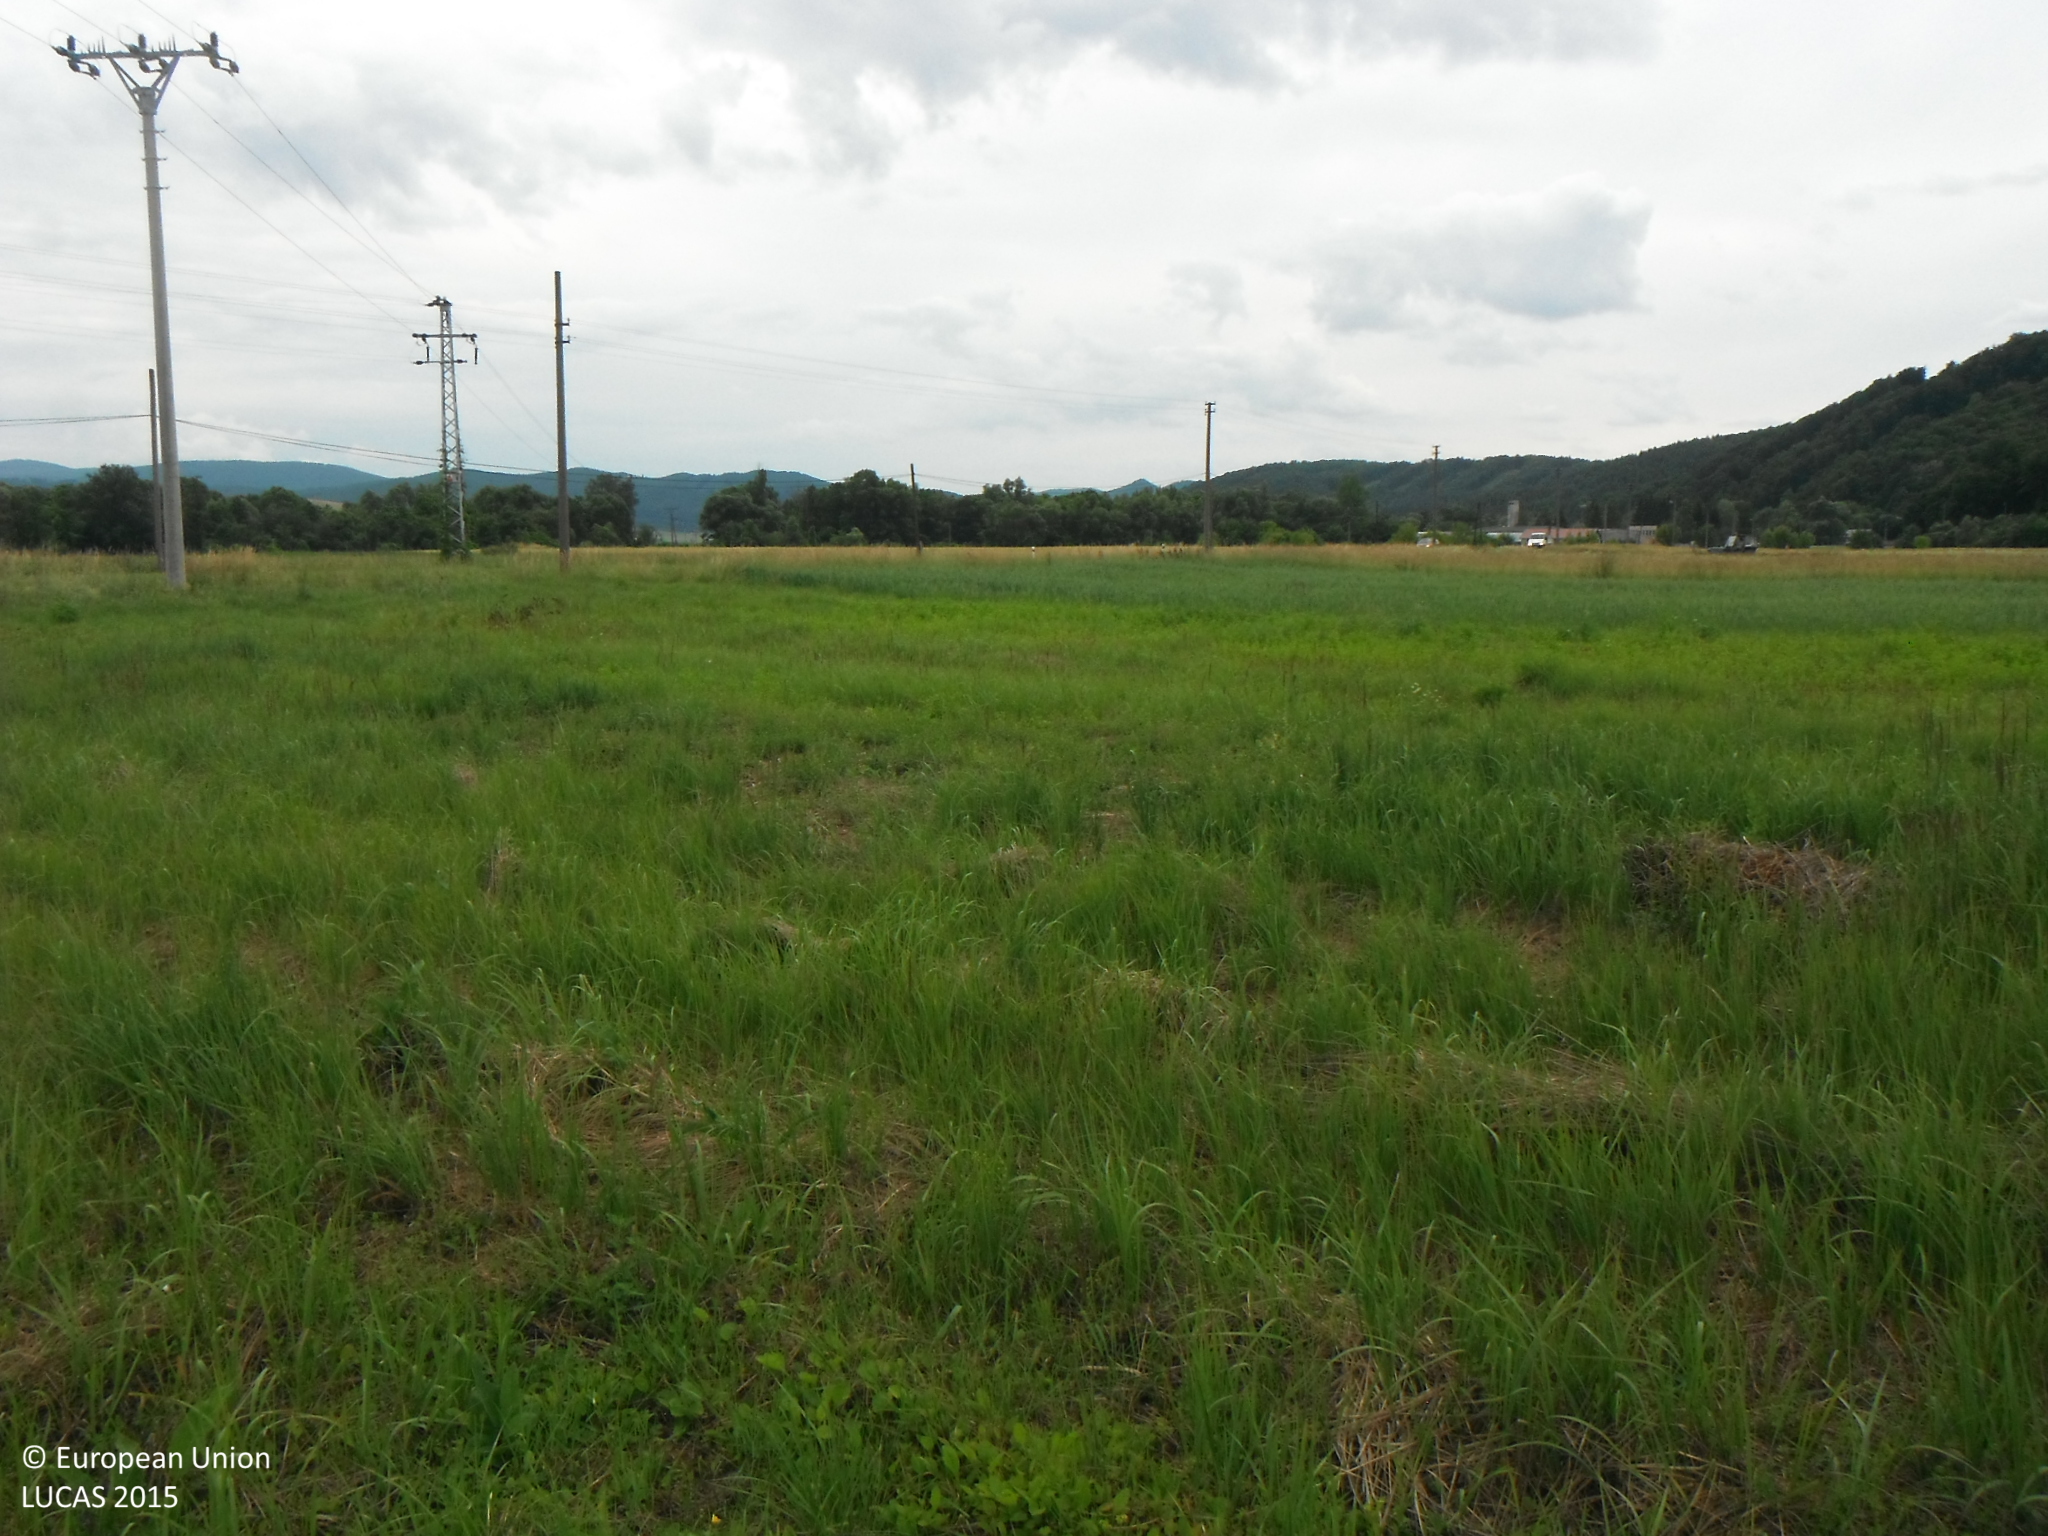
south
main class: Grassland
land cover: Grassland without tree/shrub cover
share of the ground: > 75 %
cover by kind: herbaceous plants 100 %
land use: Agriculture (excluding fallow land and kitchen gardens)
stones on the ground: < 10 %
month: June
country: SK
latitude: 48.9708
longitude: 21.9534
